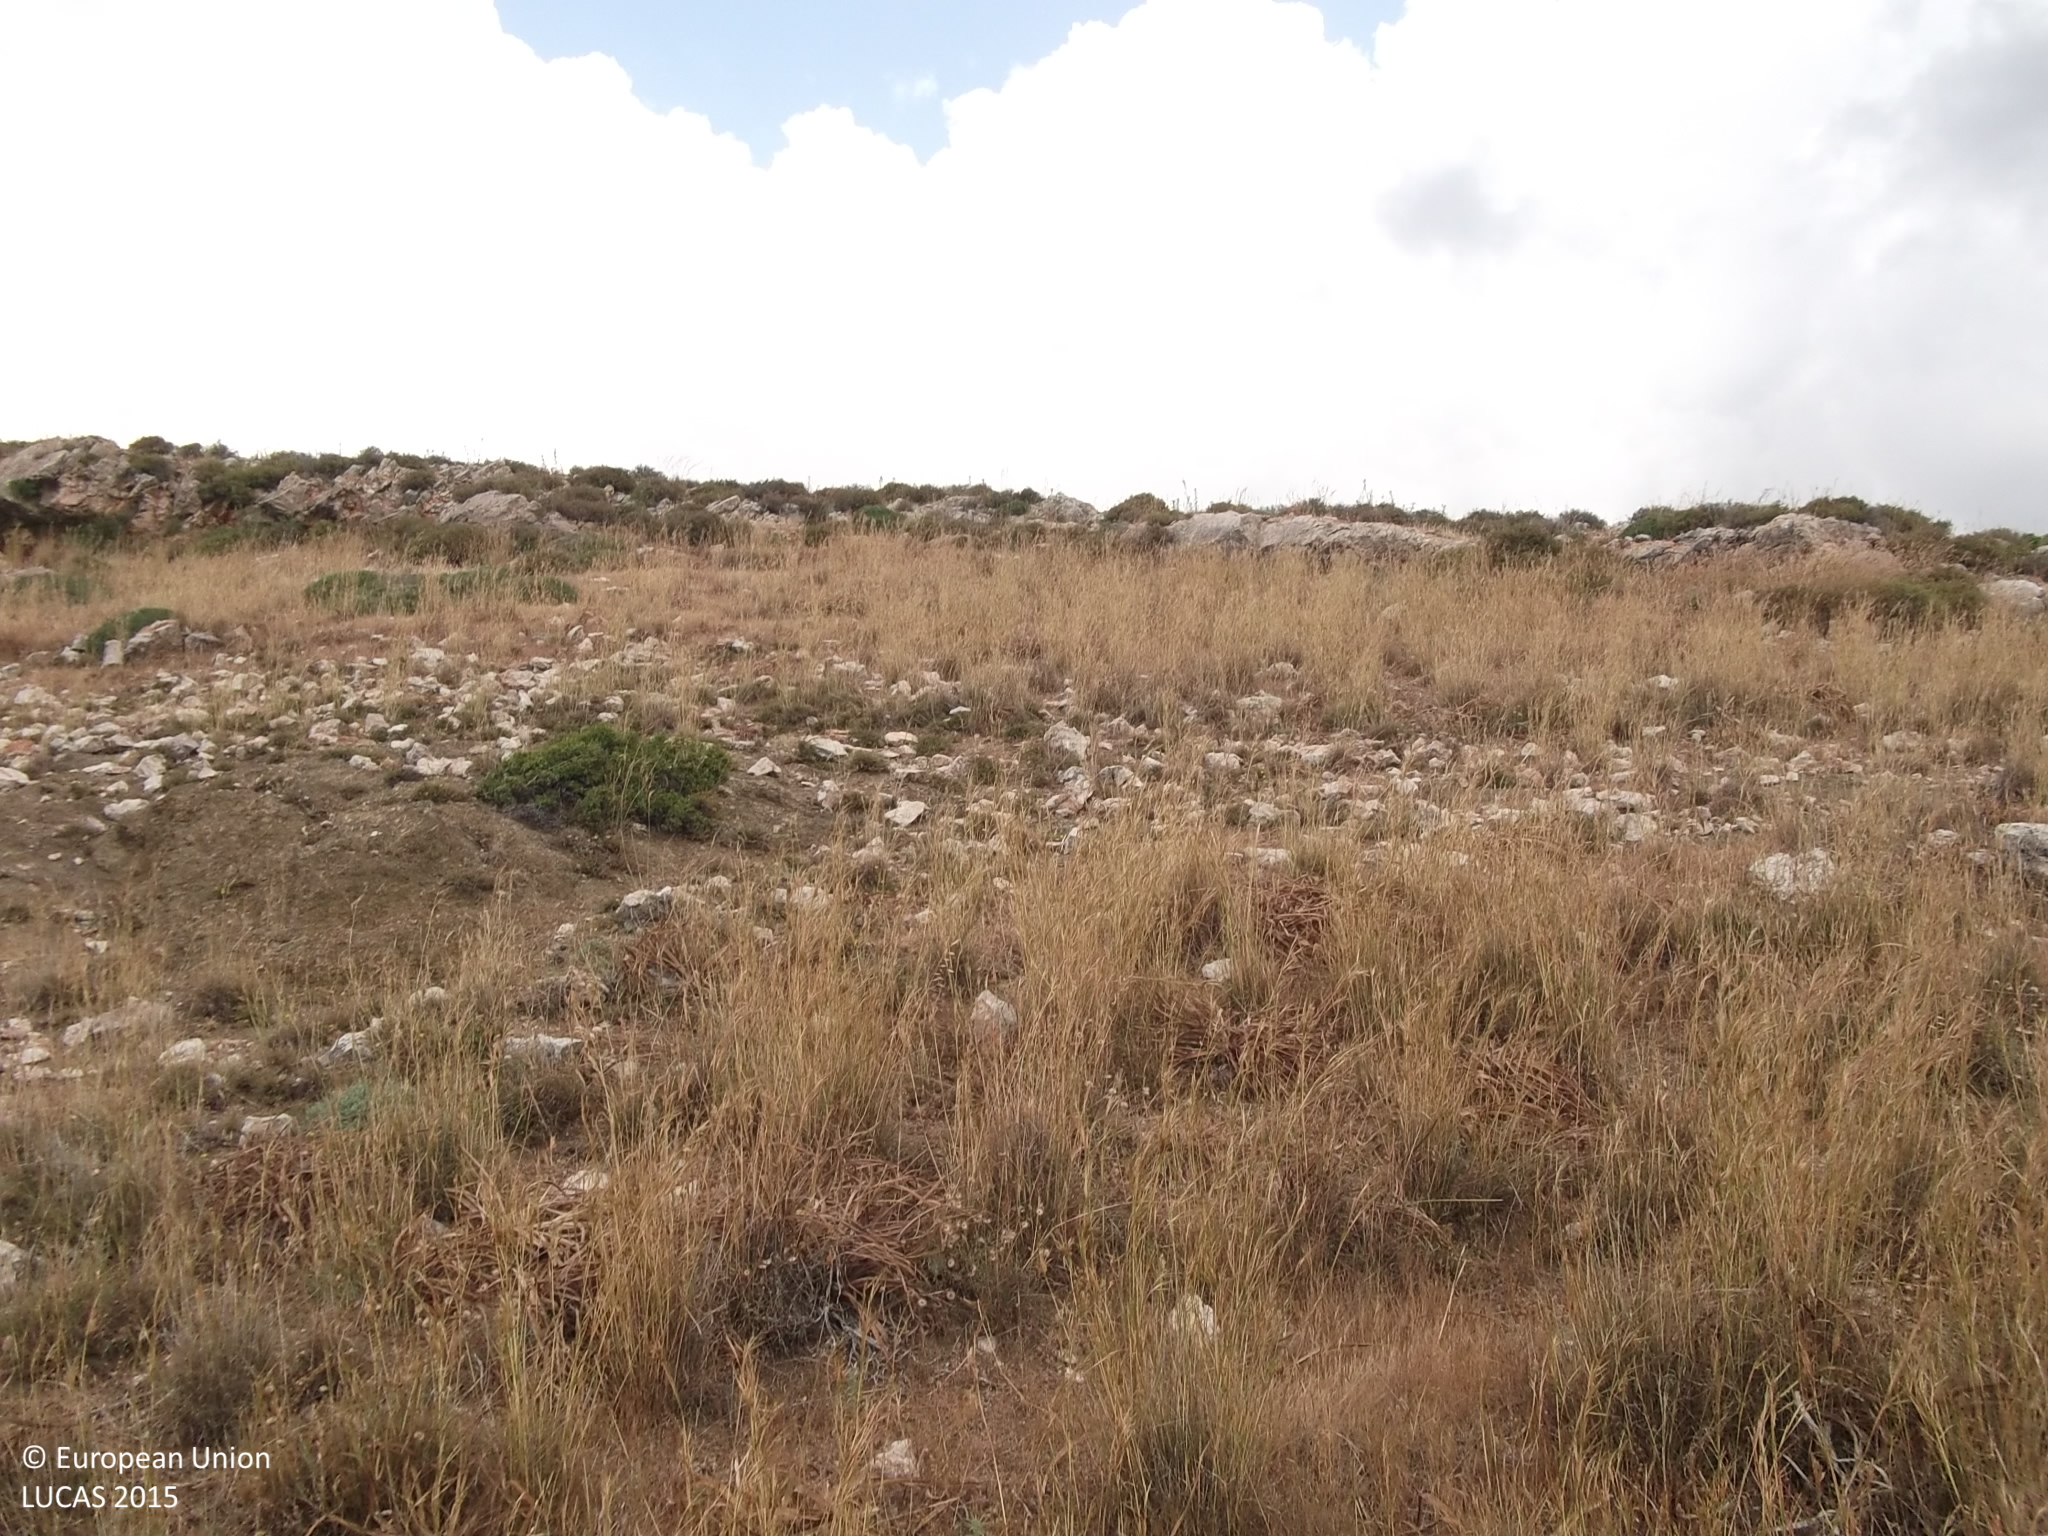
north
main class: Shrubland
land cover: Shrubland without tree cover
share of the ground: 25 - 50 %
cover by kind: herbaceous plants 50 %, shrubs 30 %, unconsolidated bare surface 20 %
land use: Semi-natural and natural areas not in use
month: May
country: CY
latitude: 34.7620
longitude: 32.5341
